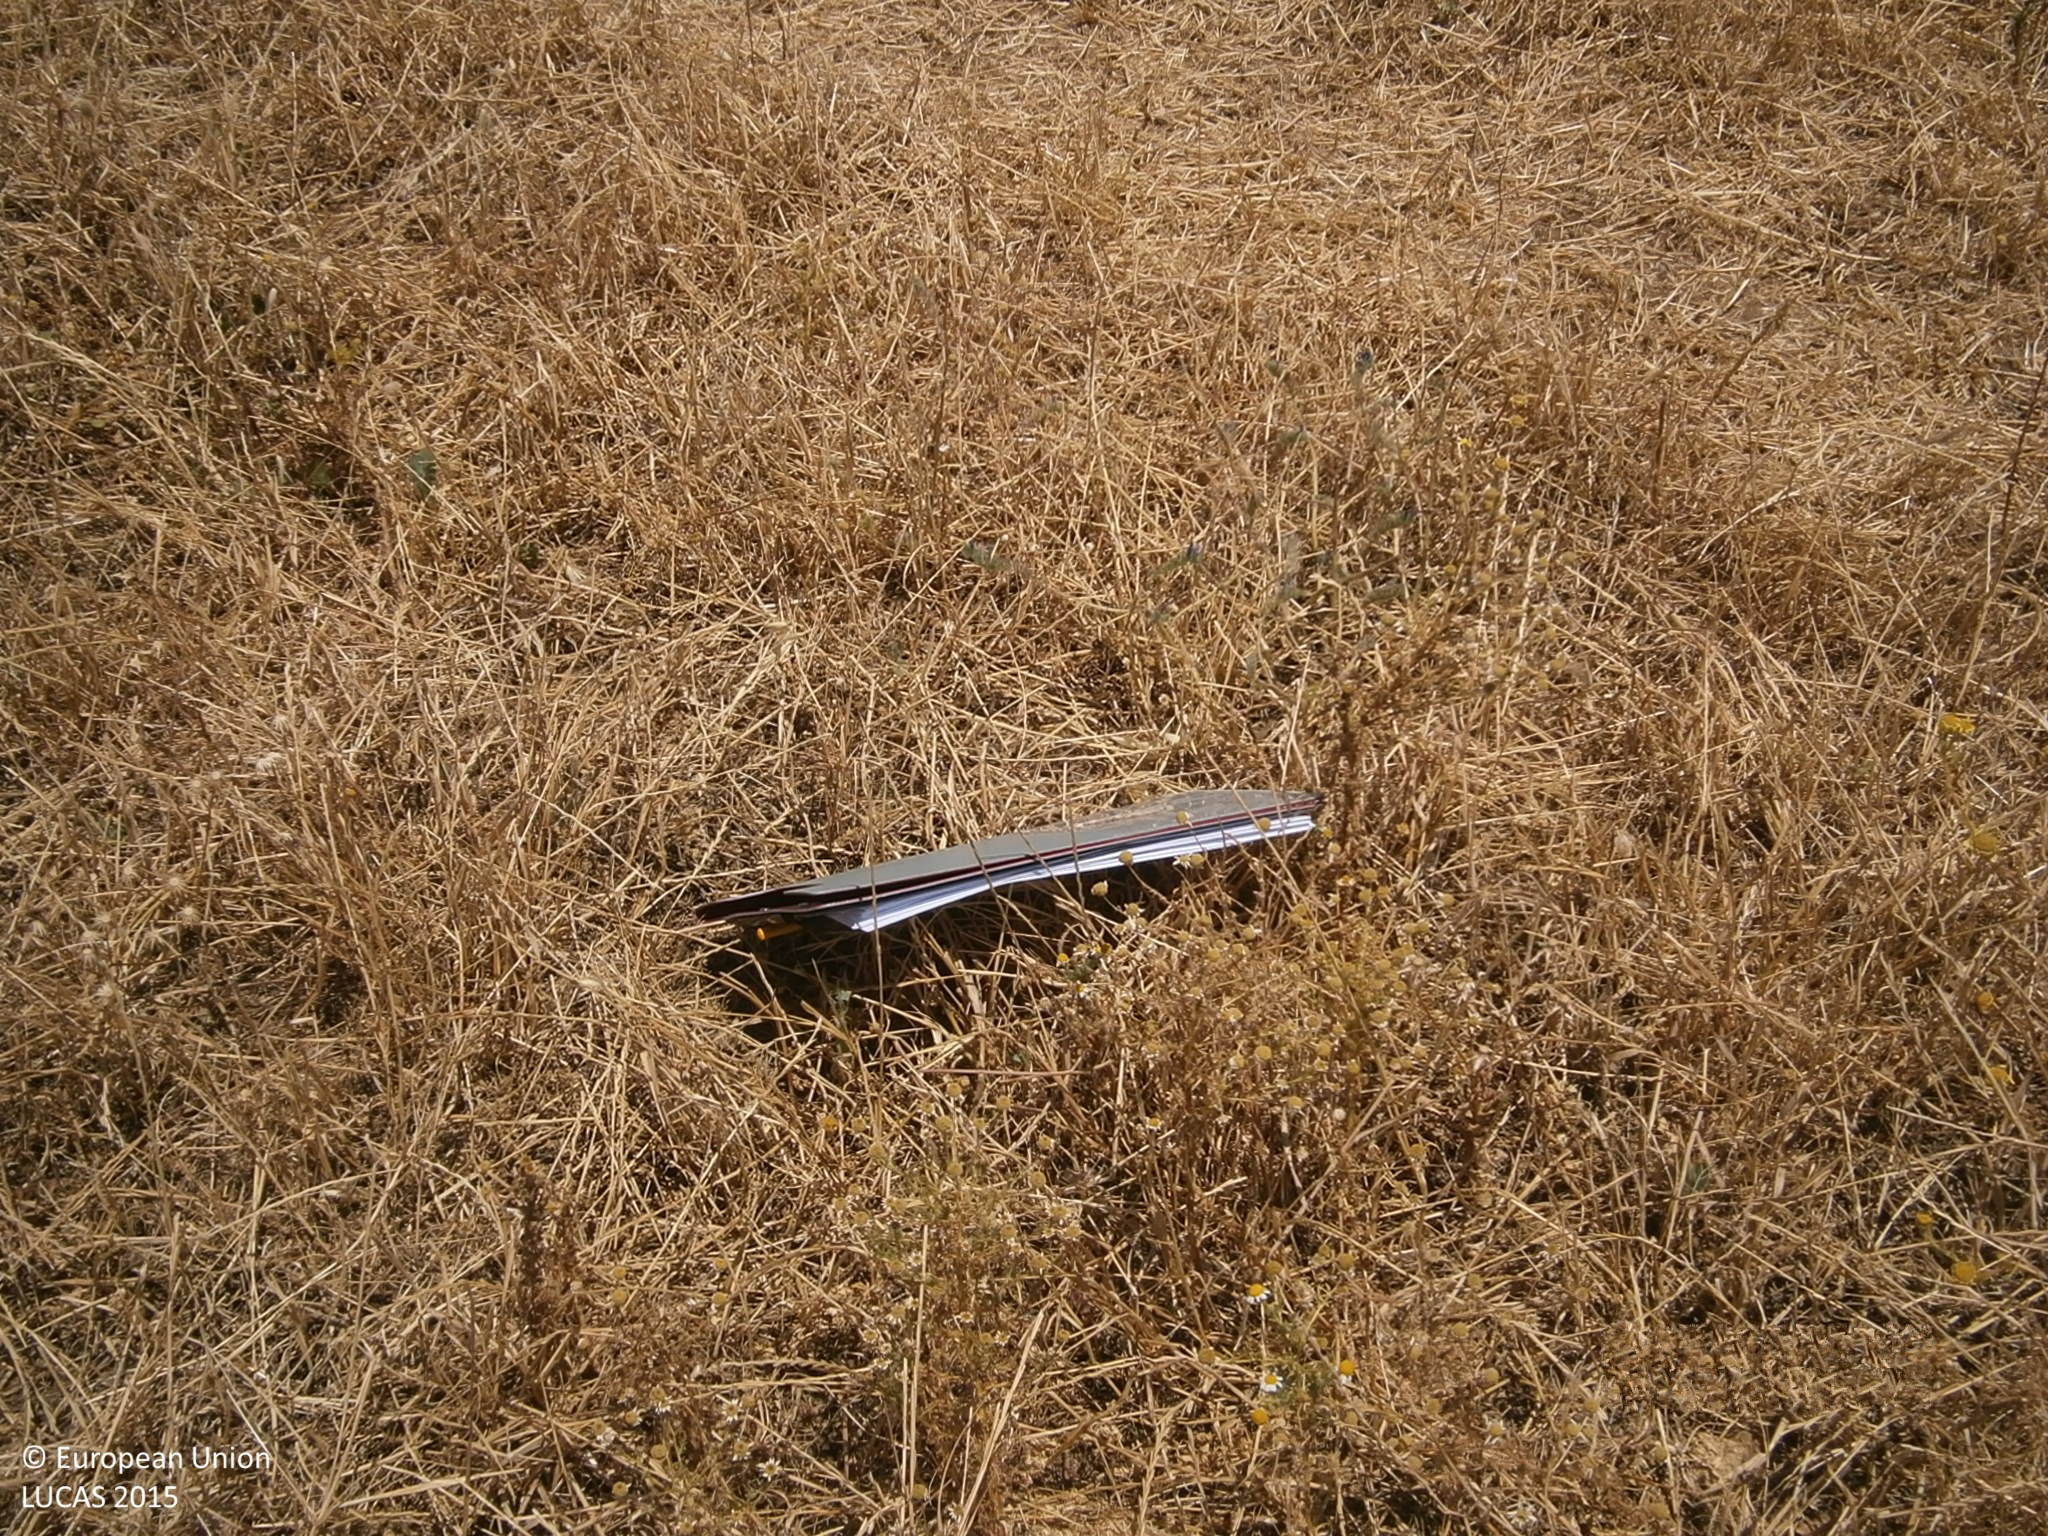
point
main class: Grassland
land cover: Grassland without tree/shrub cover
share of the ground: > 75 %
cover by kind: herbaceous plants 95 %
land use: Agriculture (excluding fallow land and kitchen gardens)
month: June
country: ES
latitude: 38.6761
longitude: -6.3879
